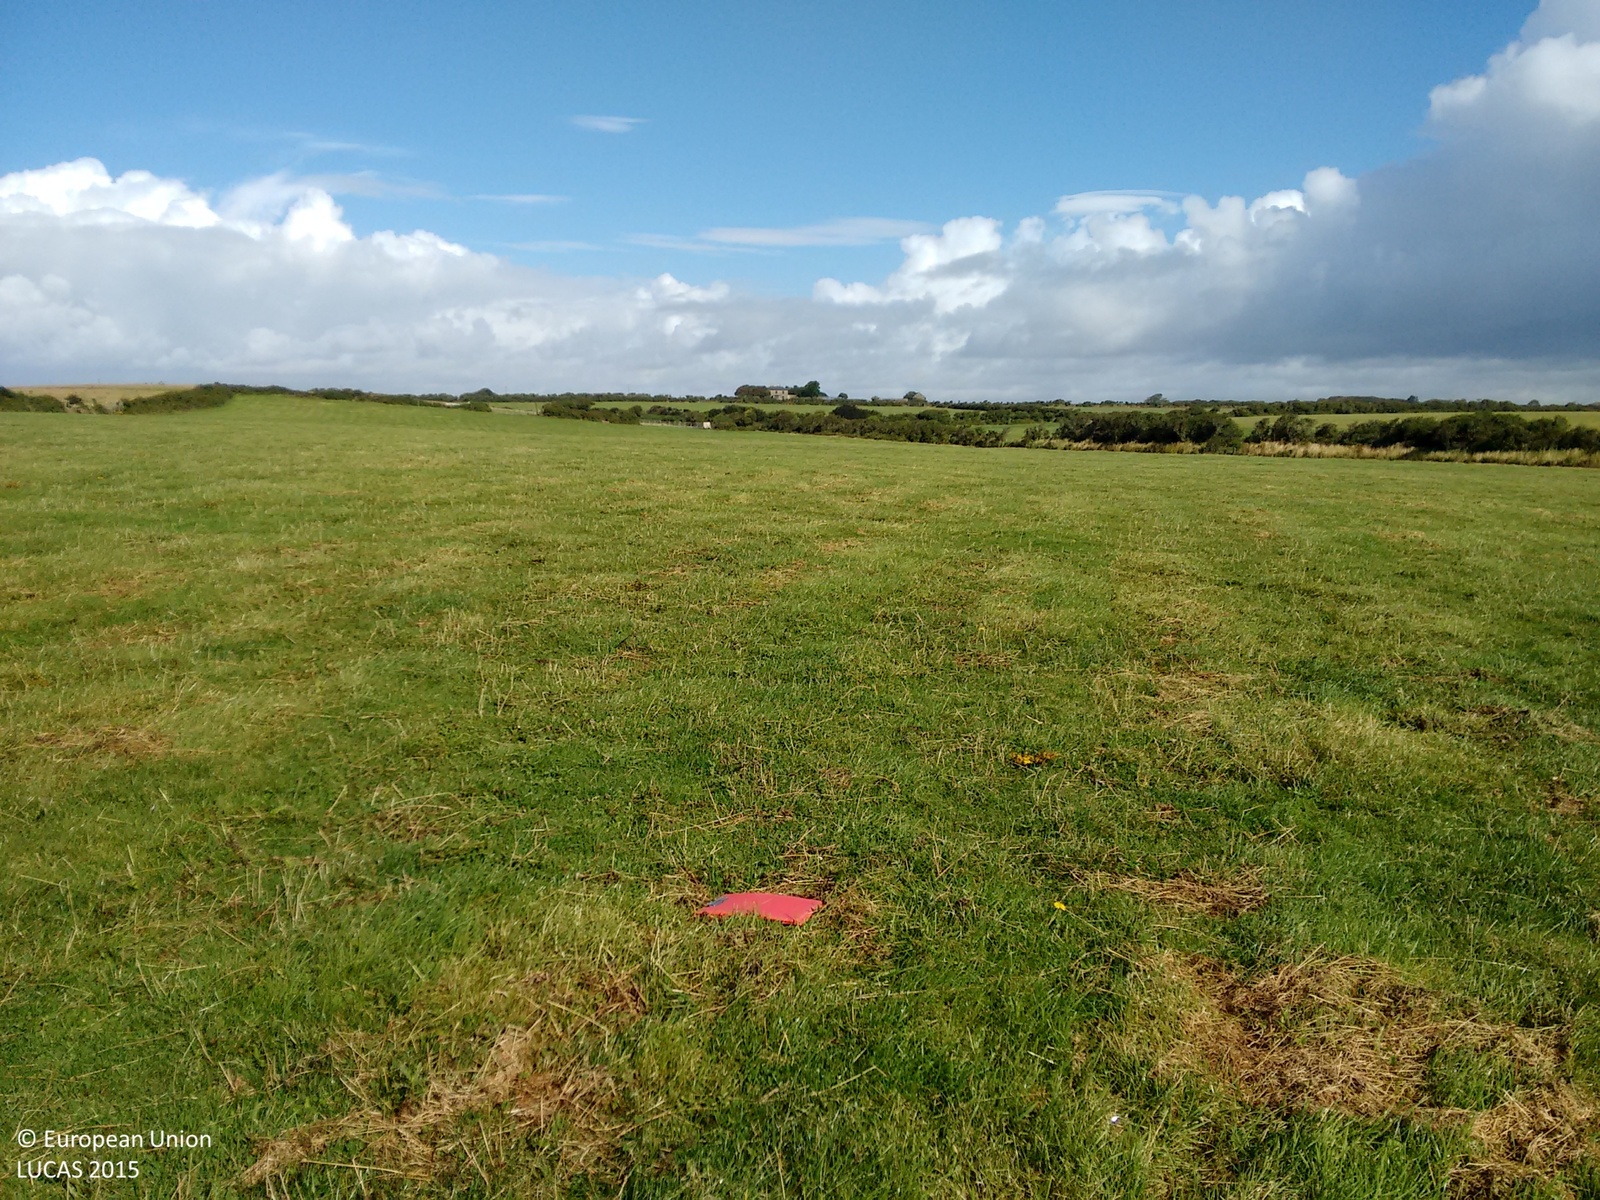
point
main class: Grassland
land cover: Grassland without tree/shrub cover
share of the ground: > 75 %
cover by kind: herbaceous plants 100 %
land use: Agriculture (excluding fallow land and kitchen gardens)
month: August
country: IE
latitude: 52.2072
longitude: -6.4729
